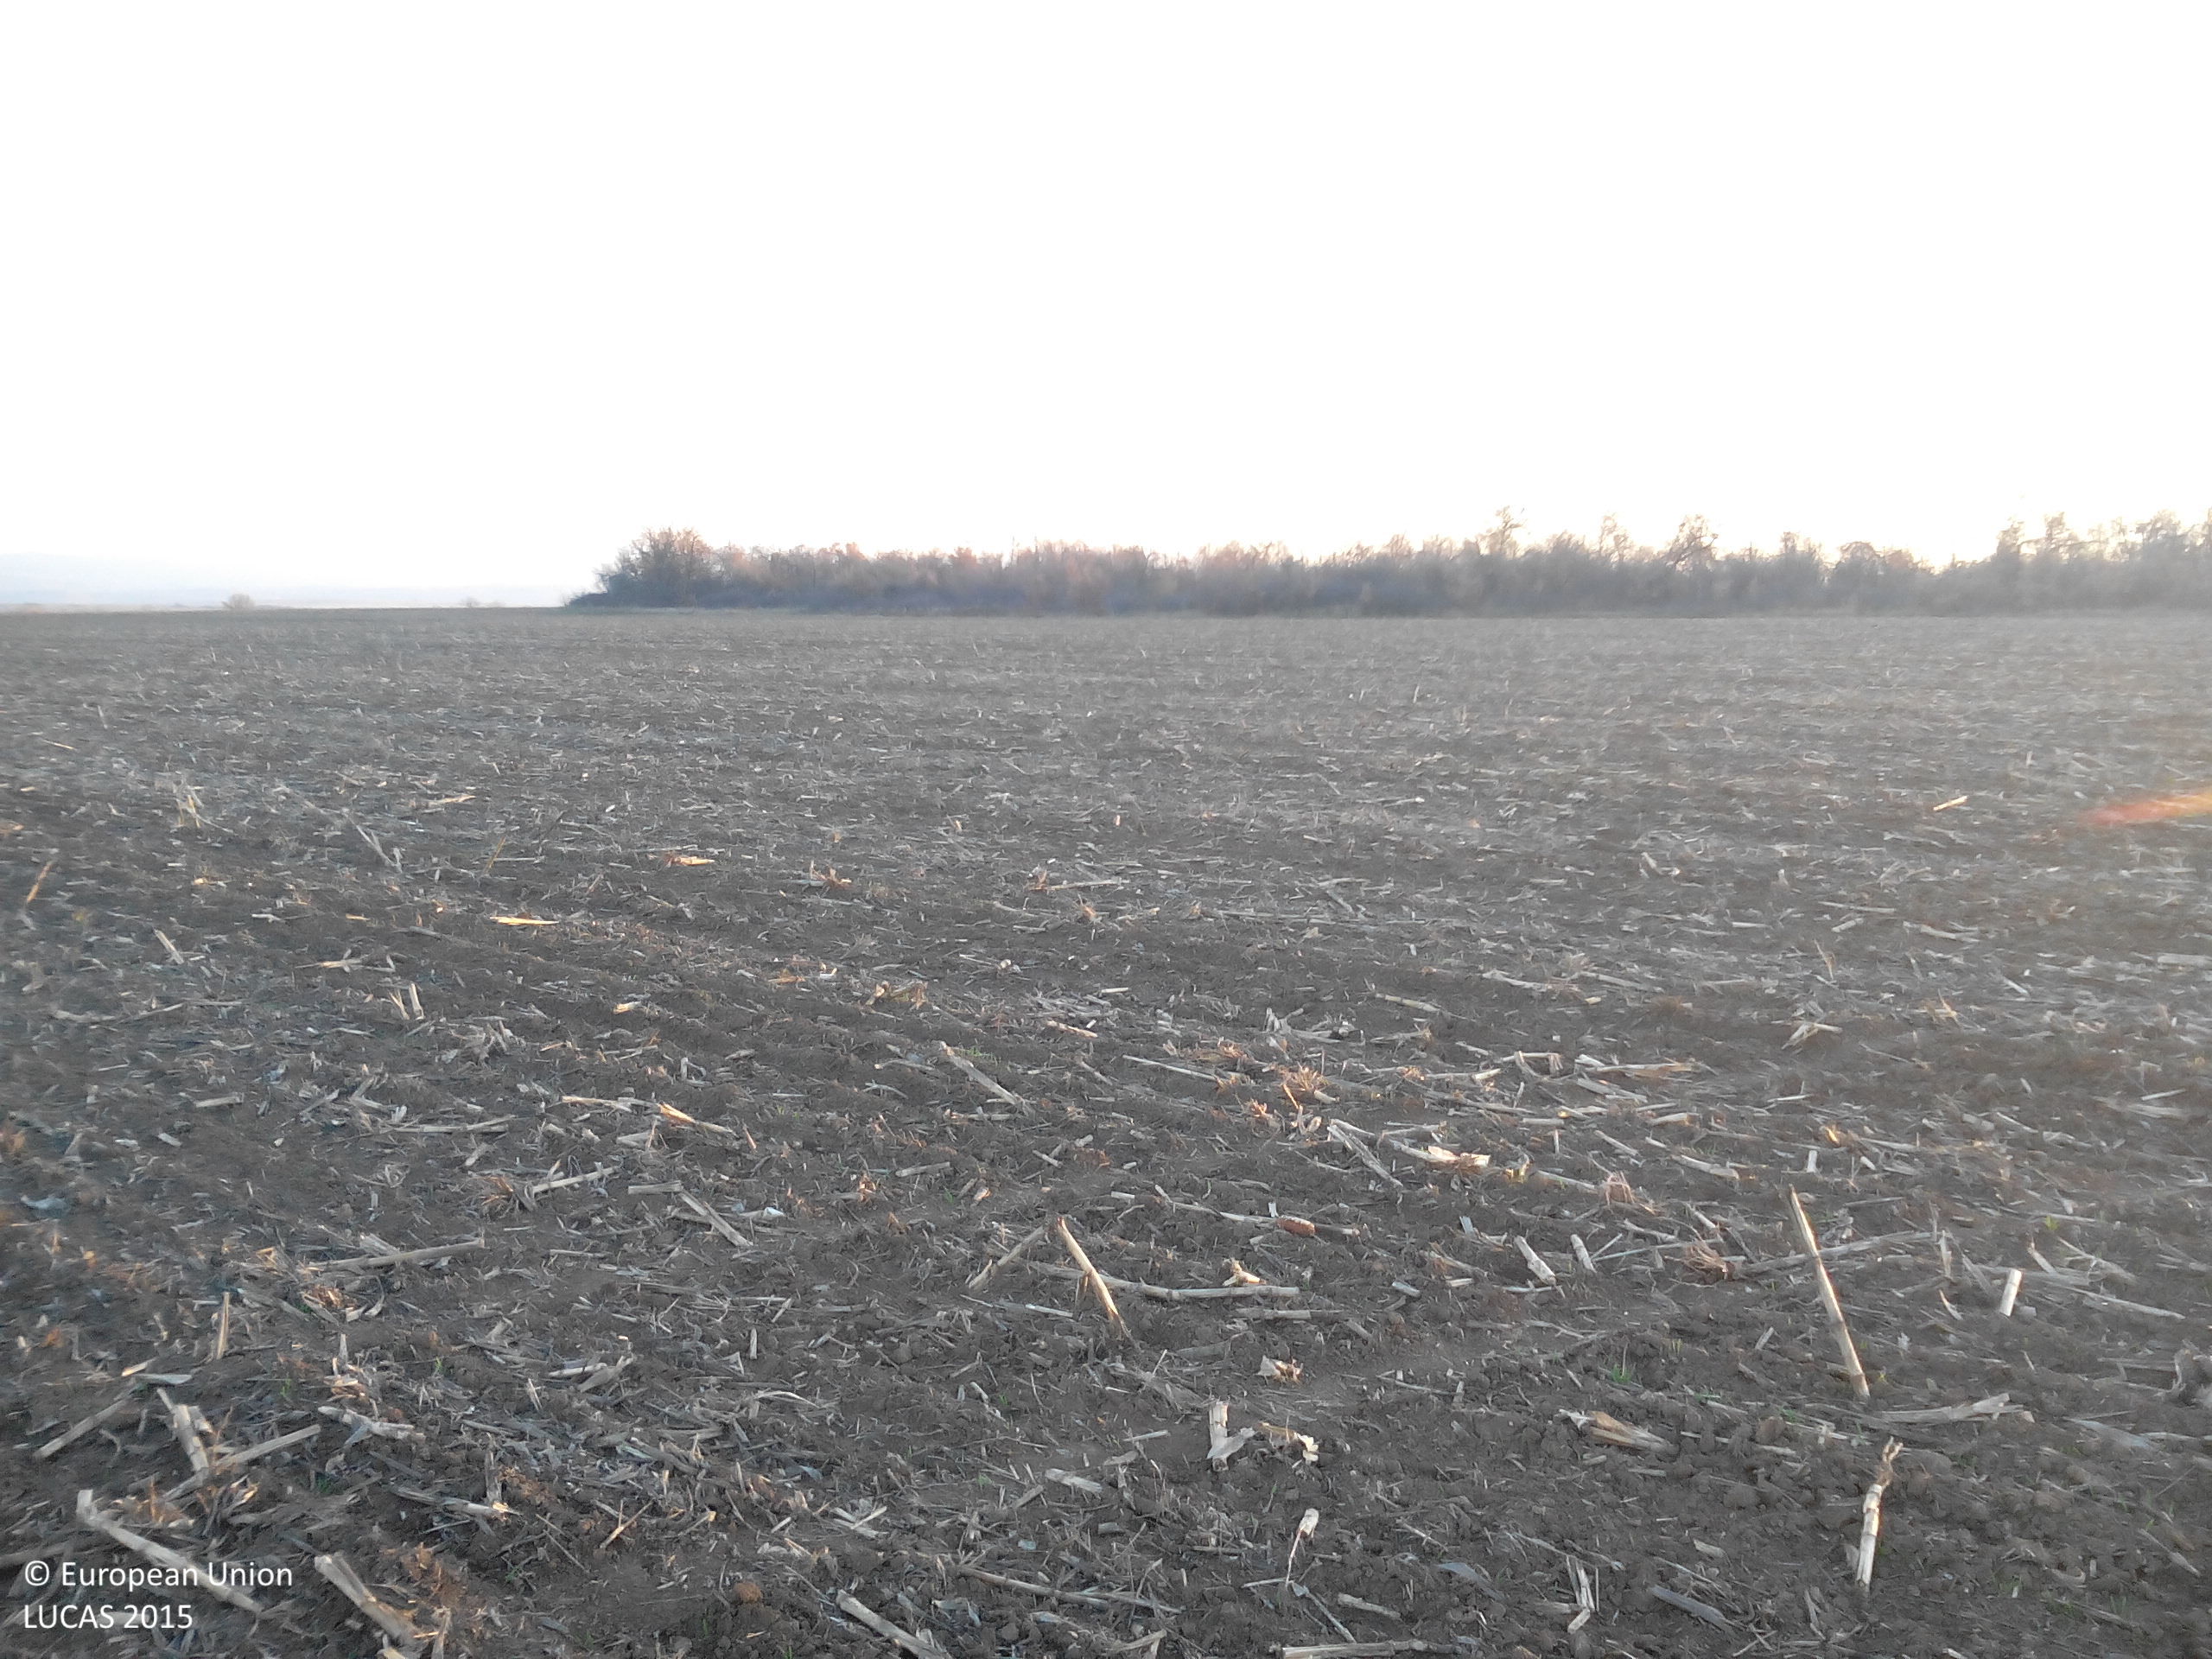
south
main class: Cropland
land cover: Maize
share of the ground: < 10 %
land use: Agriculture (excluding fallow land and kitchen gardens)
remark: Harvested field
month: November
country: BG
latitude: 43.2380
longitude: 23.9523
